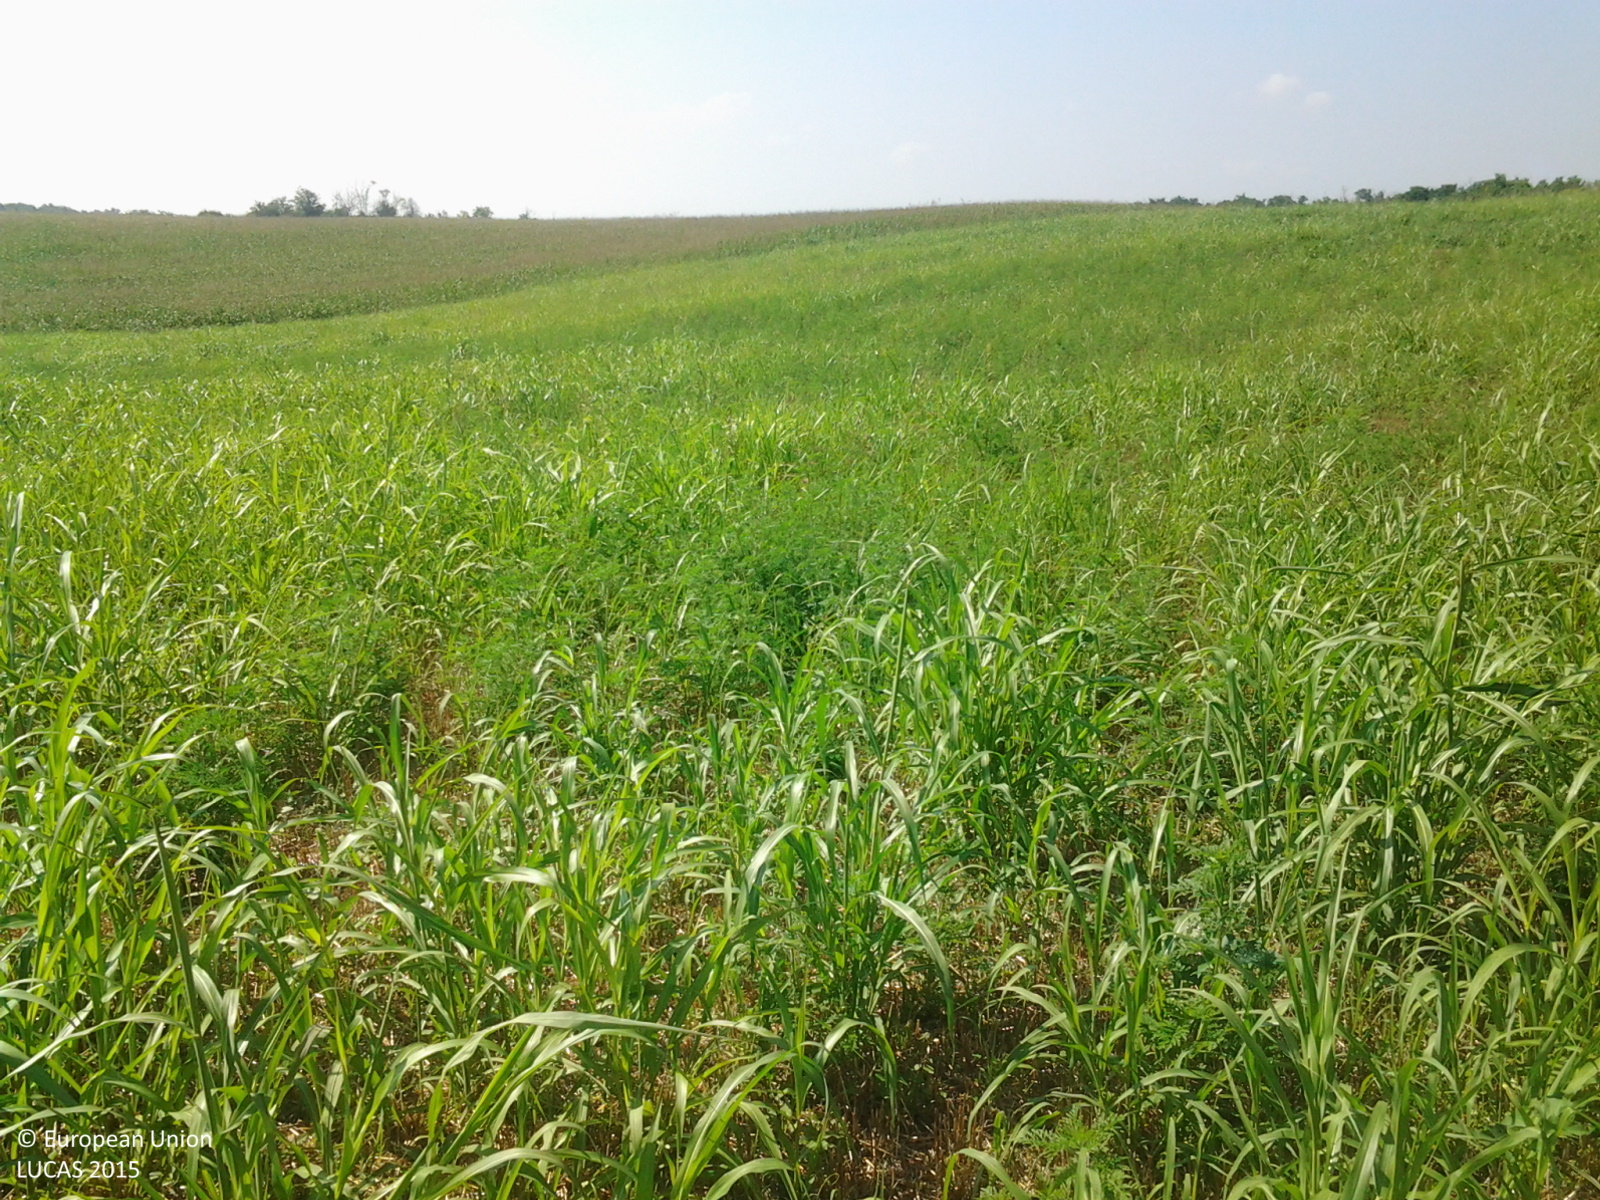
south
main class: Cropland
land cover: Common wheat
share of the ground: < 10 %
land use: Agriculture (excluding fallow land and kitchen gardens)
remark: Harvested field
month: August
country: HU
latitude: 46.7980
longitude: 18.4092
